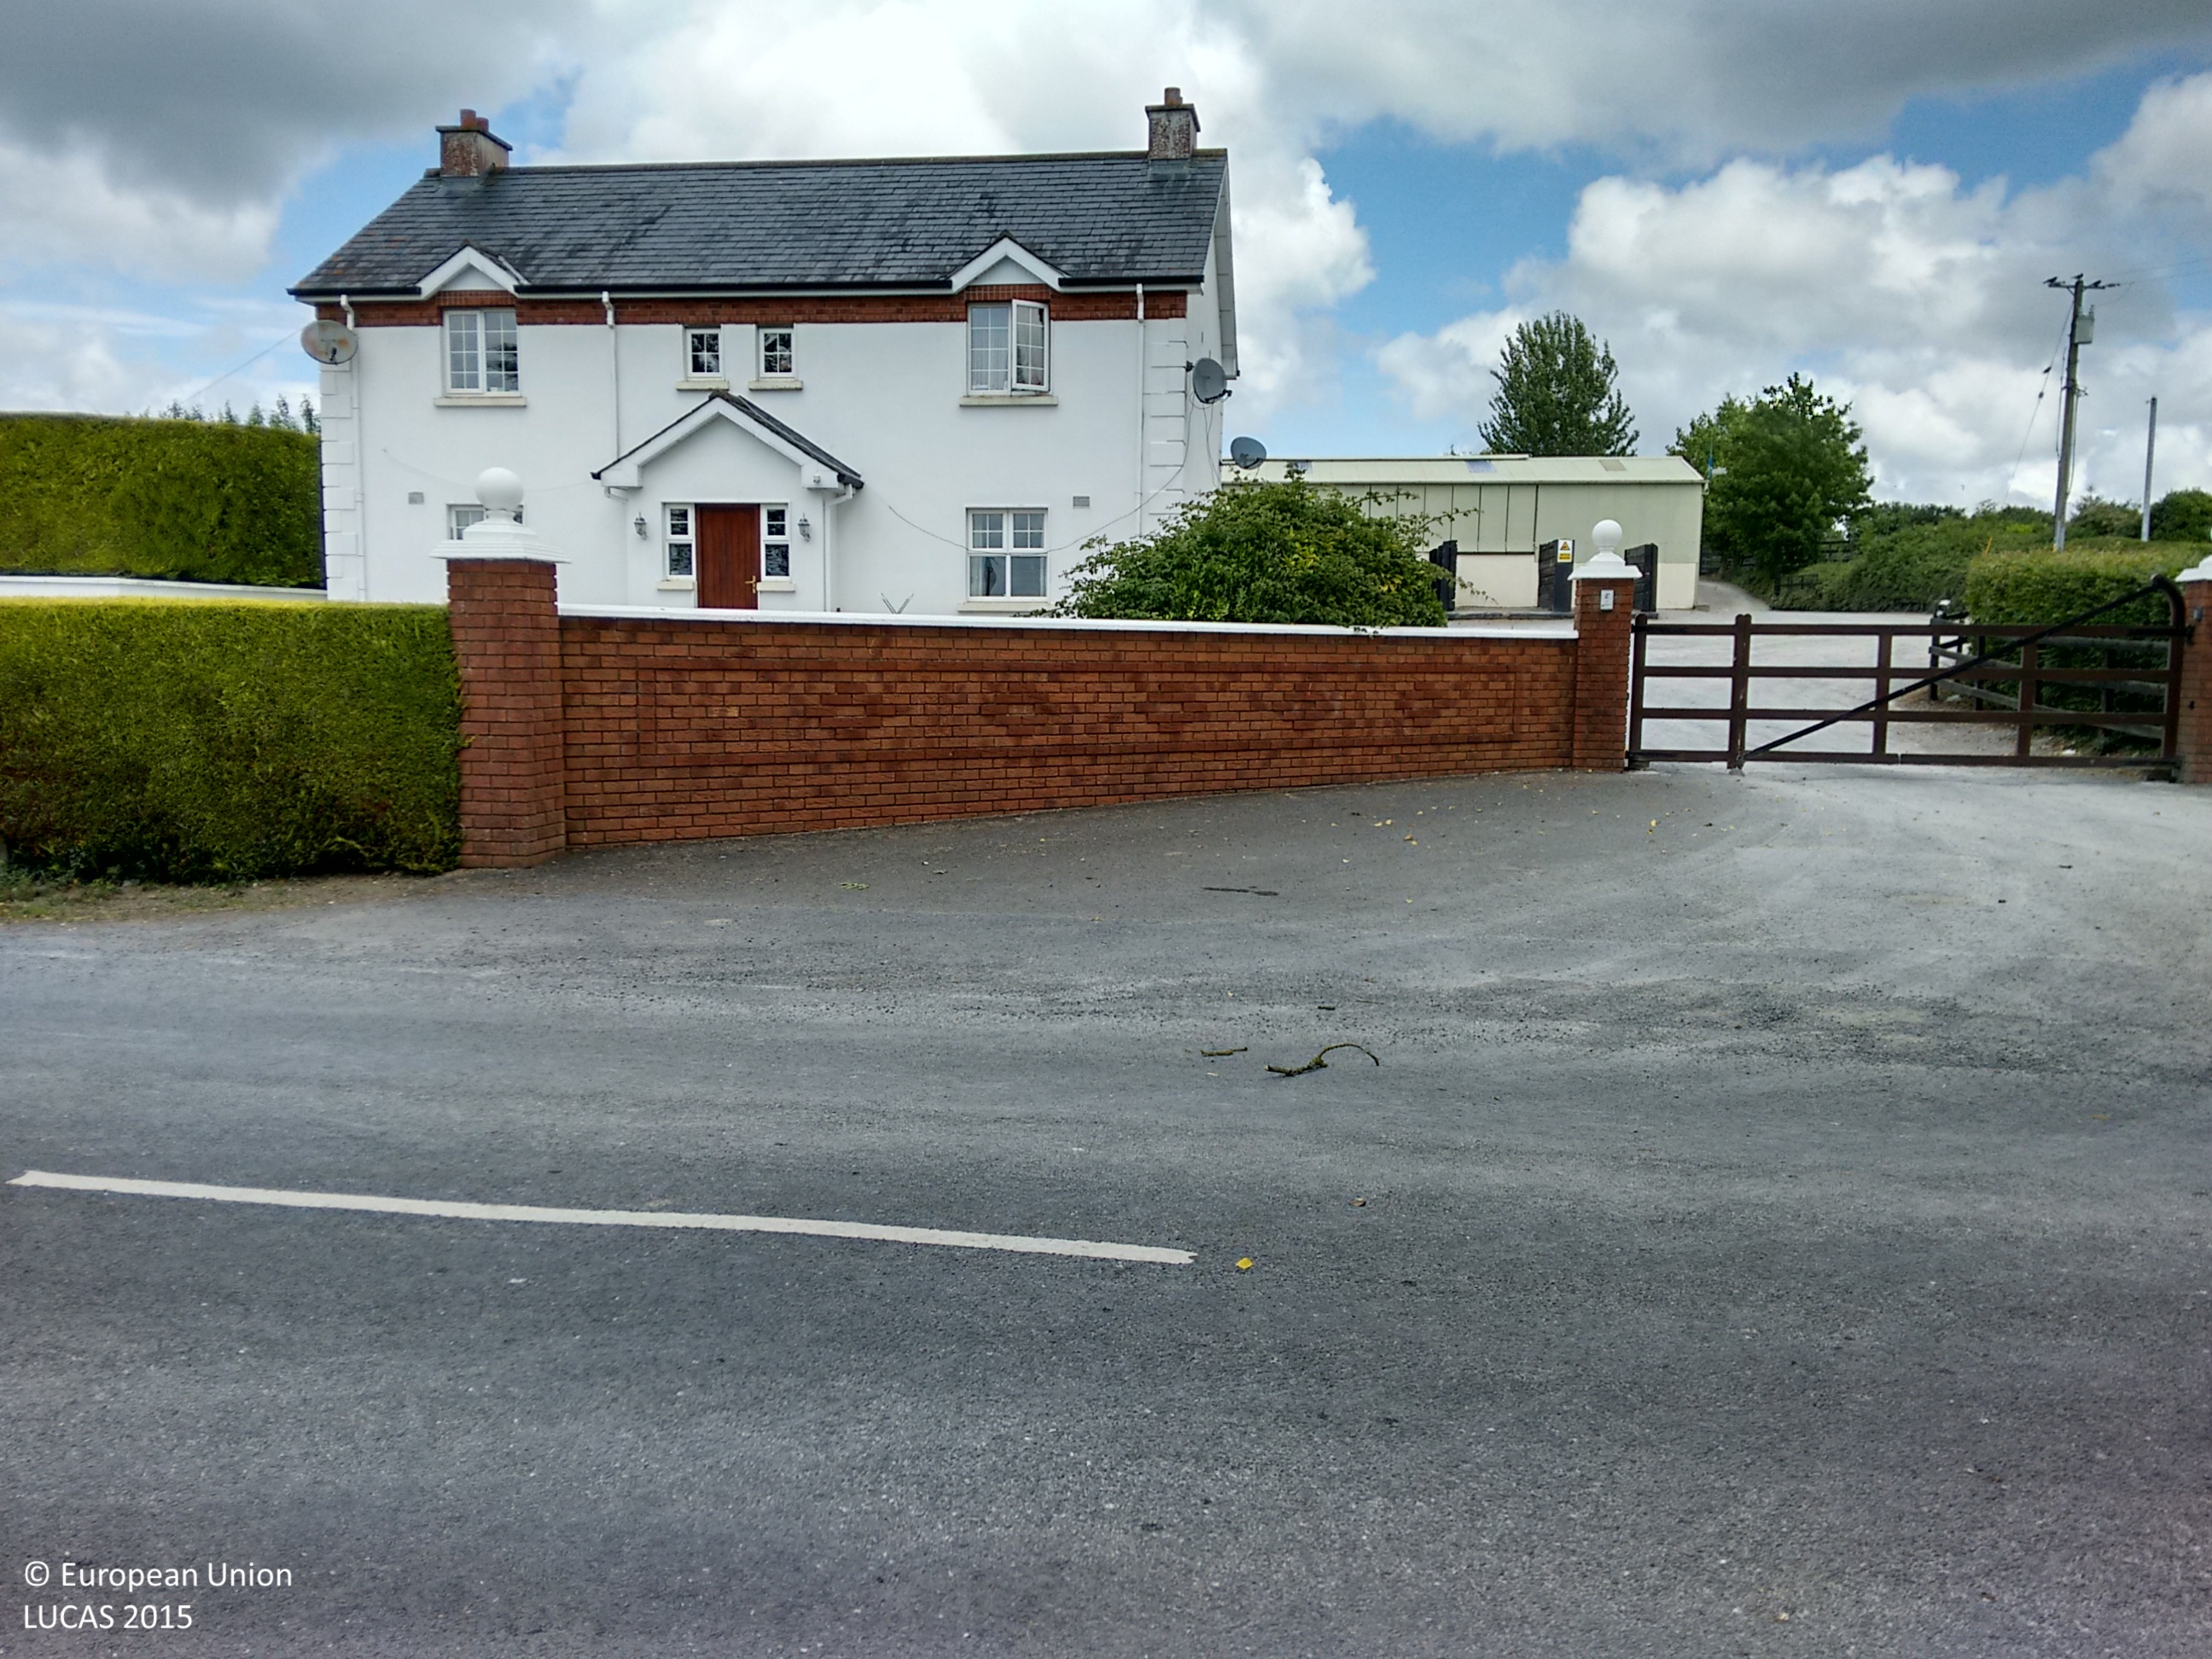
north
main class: Grassland
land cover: Grassland without tree/shrub cover
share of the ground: > 75 %
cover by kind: herbaceous plants 100 %
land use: Agriculture (excluding fallow land and kitchen gardens)
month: July
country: IE
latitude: 52.5262
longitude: -7.6907
